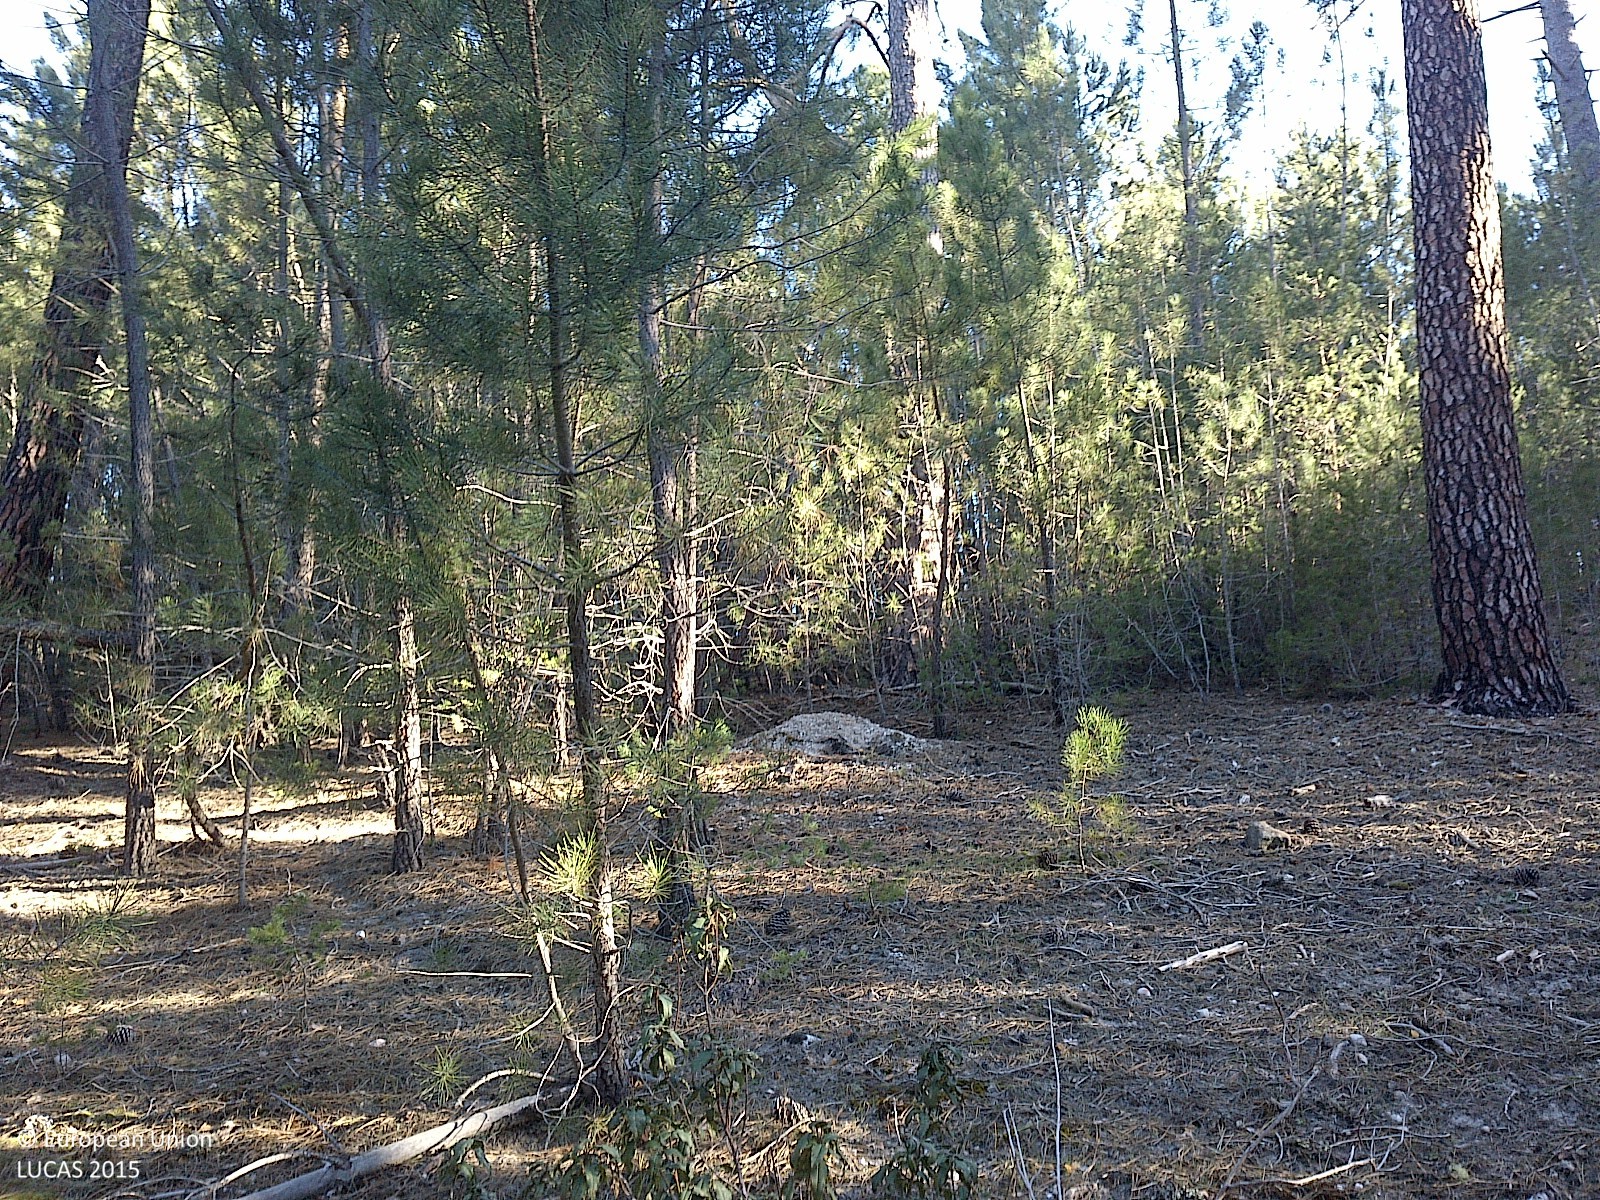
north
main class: Woodland
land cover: Pine dominated coniferous woodland
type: coniferous forest of the mediterranean region
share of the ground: 50 - 75 %
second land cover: Spontaneously vegetated surfaces
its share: 50 - 75 %
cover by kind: coniferous forest trees 85 %, herbaceous plants 10 %, shrubs 5 %
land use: Forestry
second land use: Agriculture (excluding fallow land and kitchen gardens)
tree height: > 5 m
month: April
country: ES
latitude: 41.8582
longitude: -3.0681
